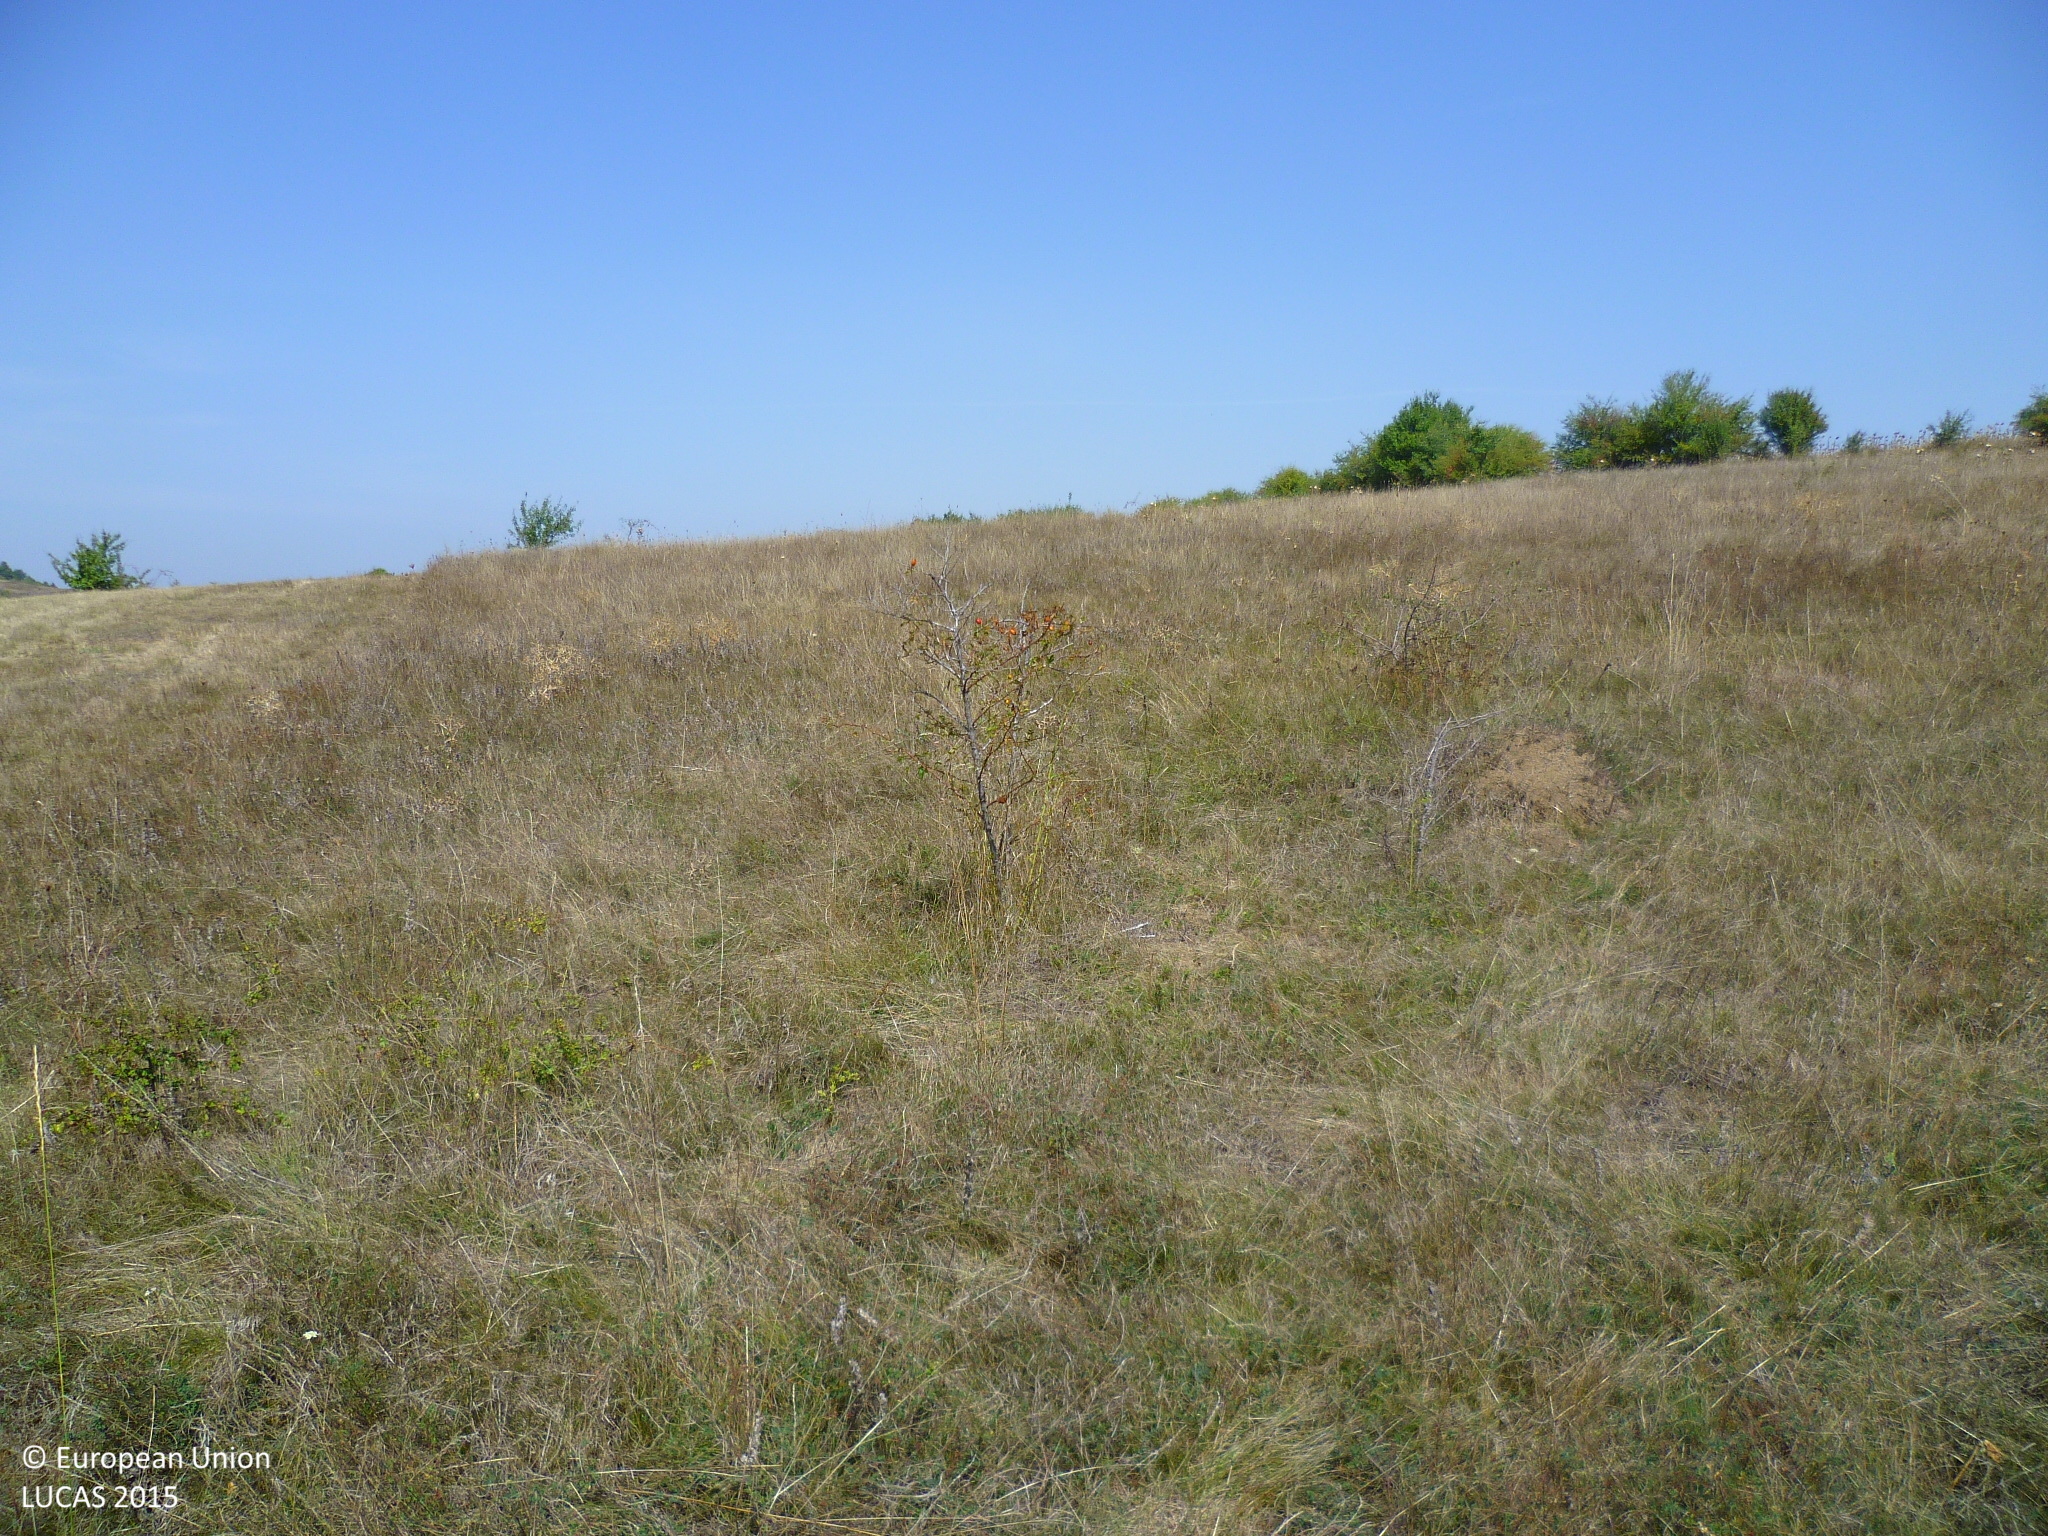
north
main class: Grassland
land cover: Grassland with sparse tree/shrub cover
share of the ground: > 75 %
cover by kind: herbaceous plants 90 %, broadleaved forest trees 5 %, shrubs 5 %
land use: Agriculture (excluding fallow land and kitchen gardens)
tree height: < 5 m
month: September
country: BG
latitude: 42.6060
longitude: 22.9363
